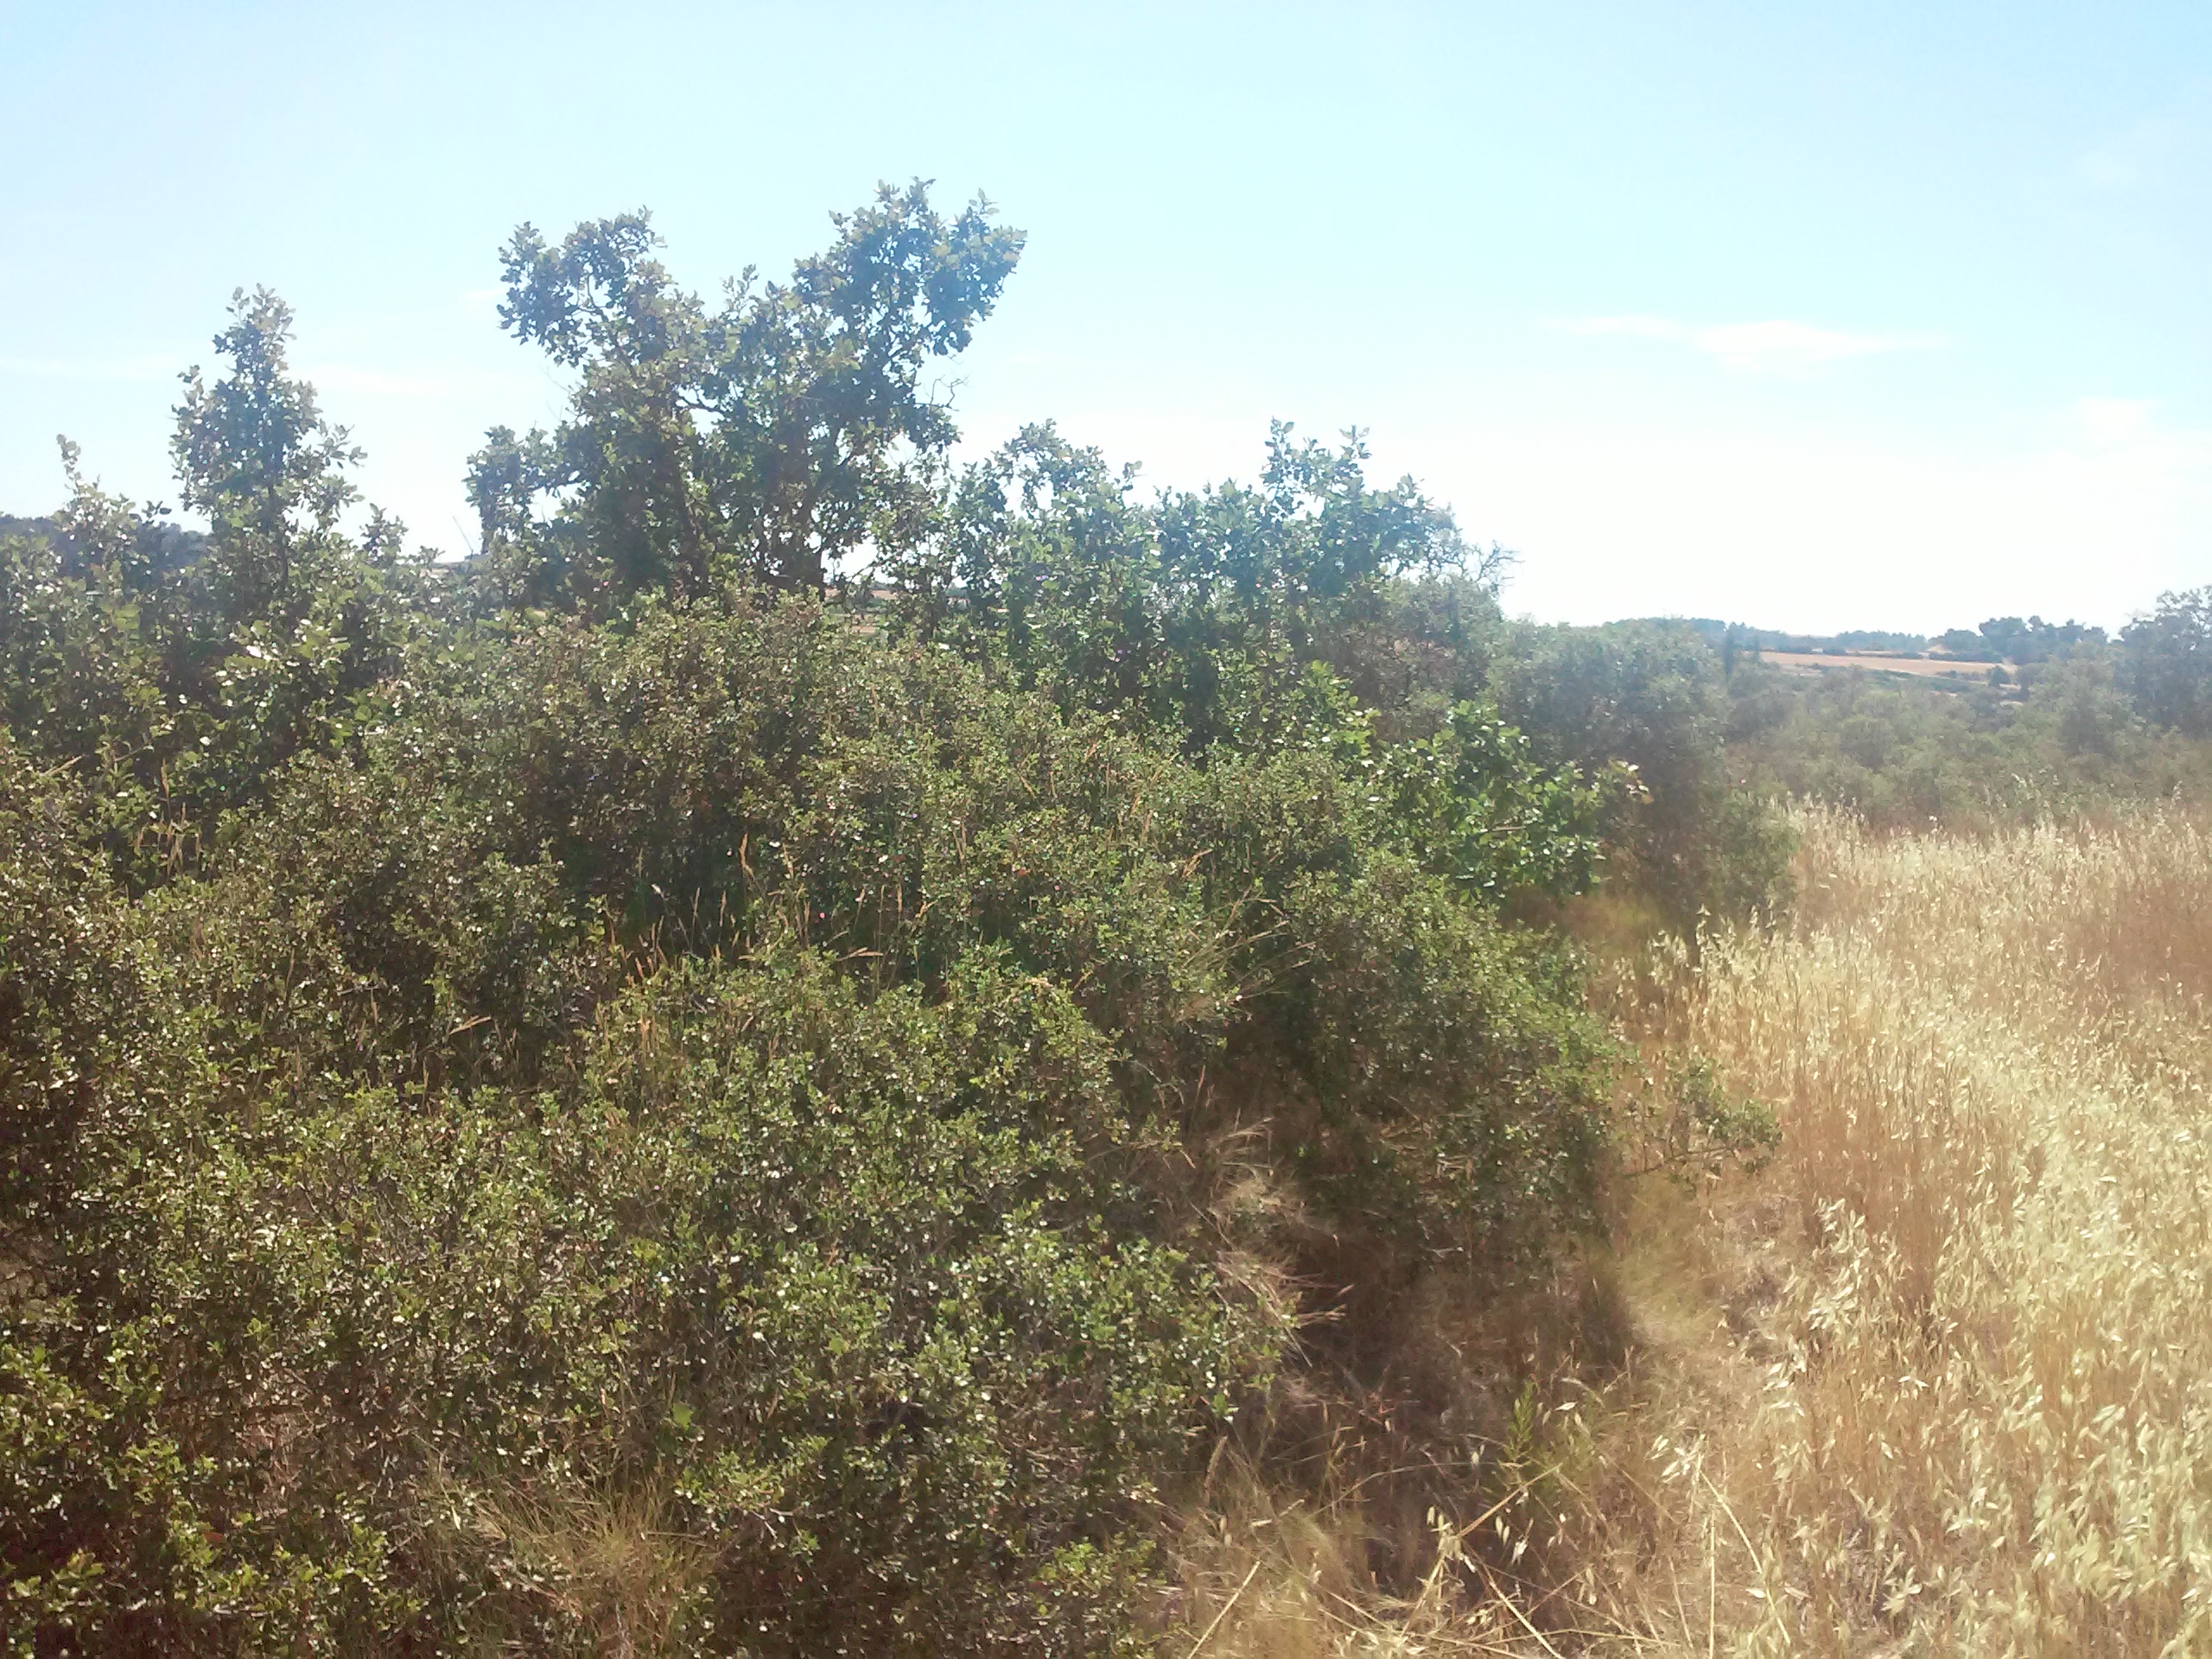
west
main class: Grassland
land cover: Grassland without tree/shrub cover
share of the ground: > 75 %
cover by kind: herbaceous plants 90 %, shrubs 5 %, consolidated bare surface 5 %
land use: Abandoned areas
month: July
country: ES
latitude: 41.5442
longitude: 1.2036
